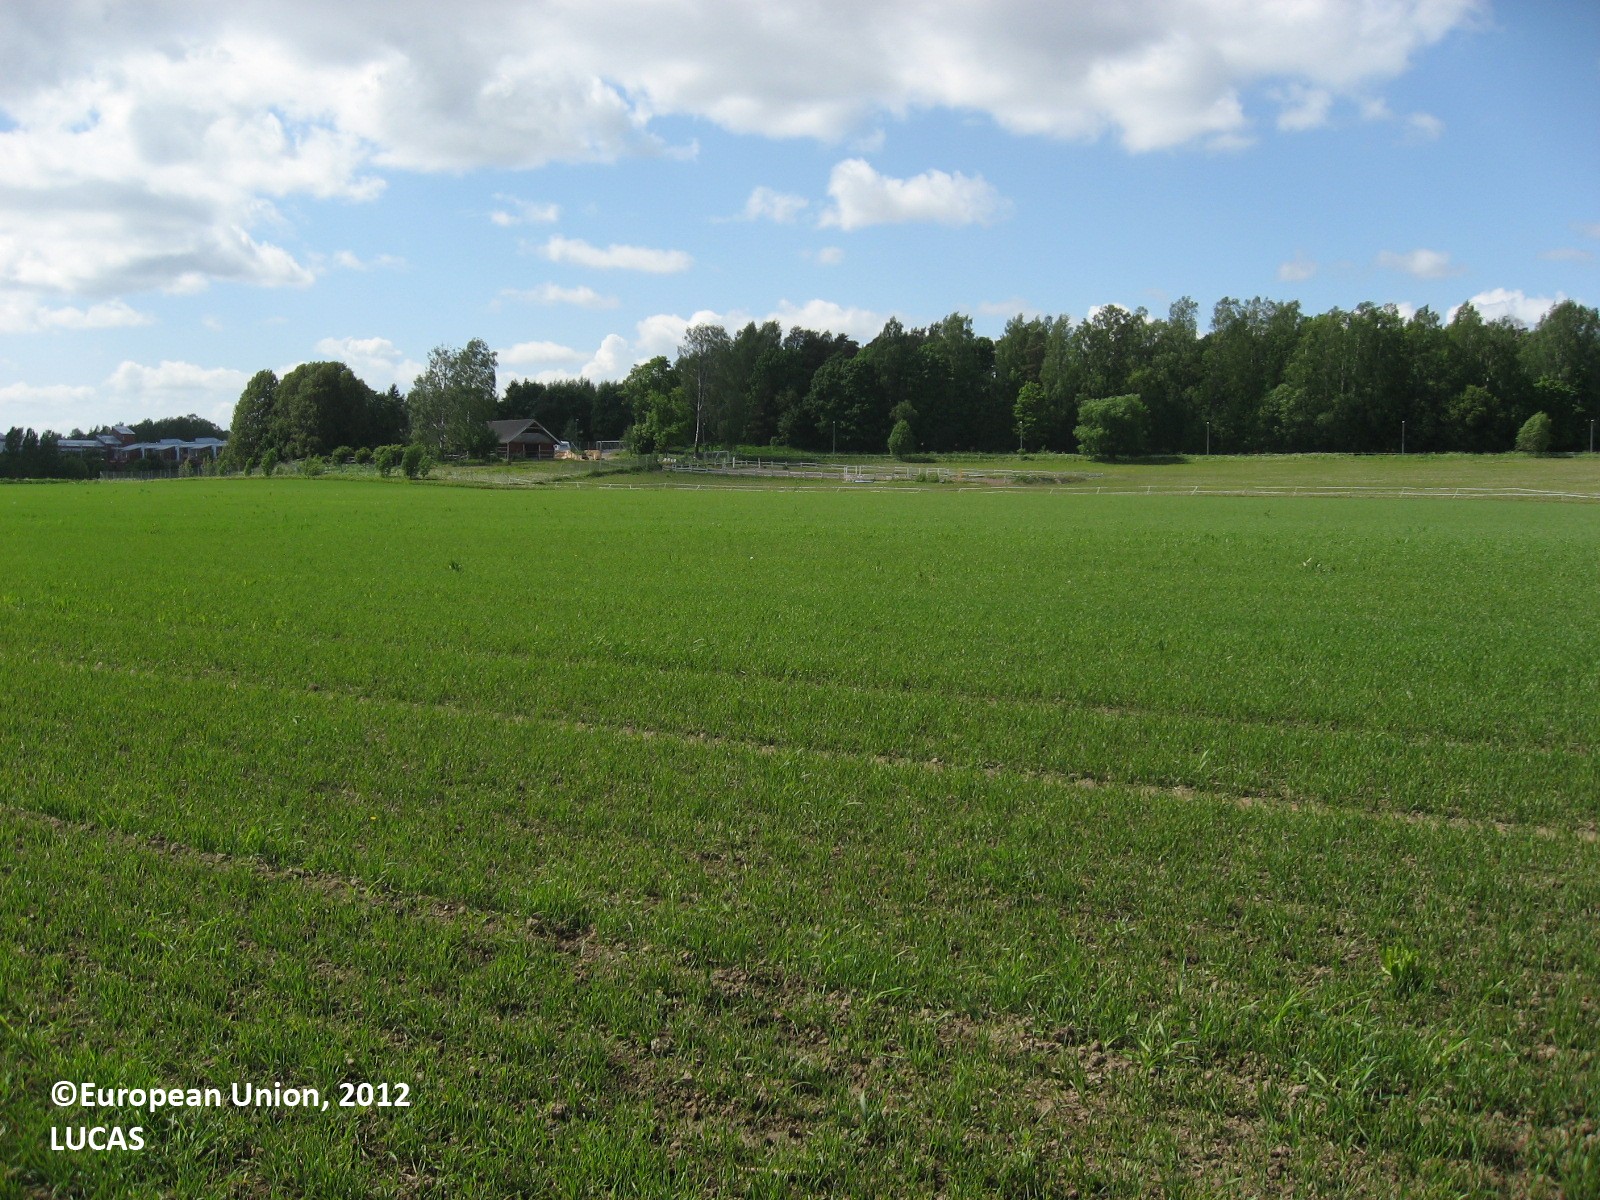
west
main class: Cropland
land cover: Common wheat
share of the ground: 50 - 75 %
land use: Agriculture (excluding fallow land and kitchen gardens)
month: June
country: FI
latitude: 60.2487
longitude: 24.8763
